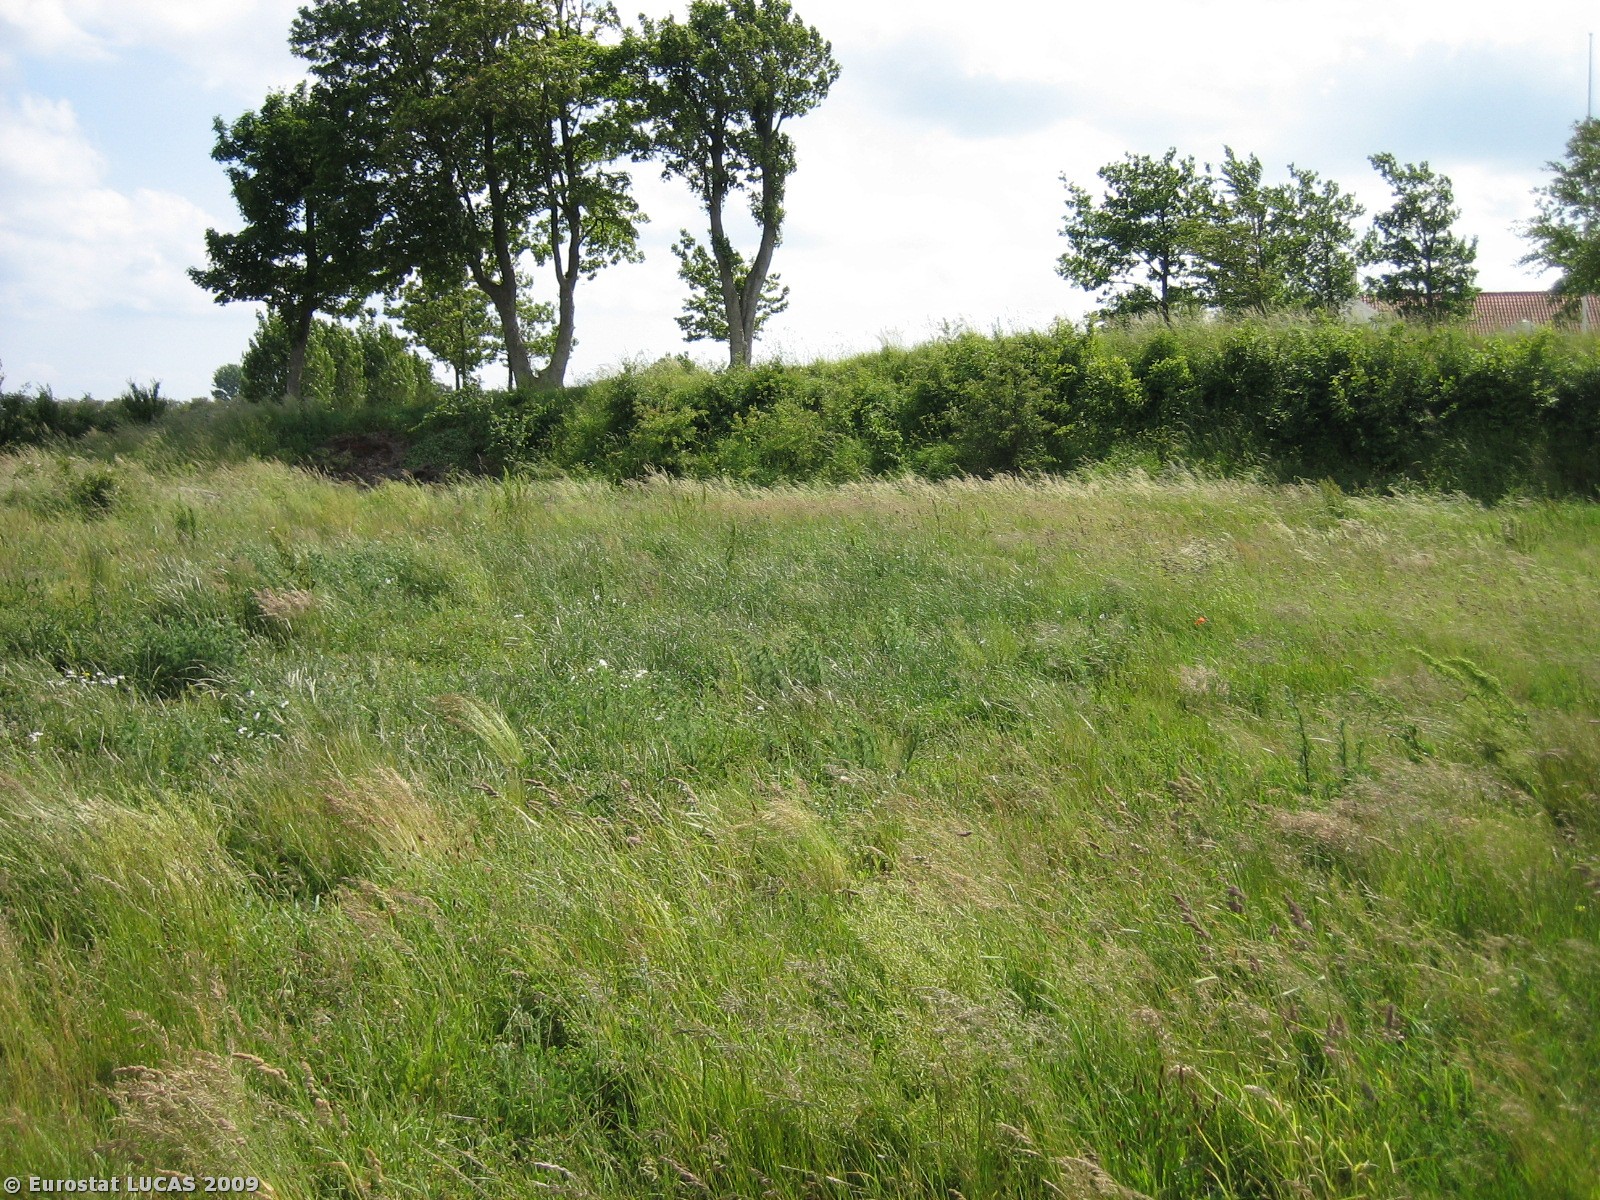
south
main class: Grassland
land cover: Grassland without tree/shrub cover
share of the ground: > 75 %
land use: Amenities, museums, leisure
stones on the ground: 25 - 50 %
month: June
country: DK
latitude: 55.8282
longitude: 10.0160
